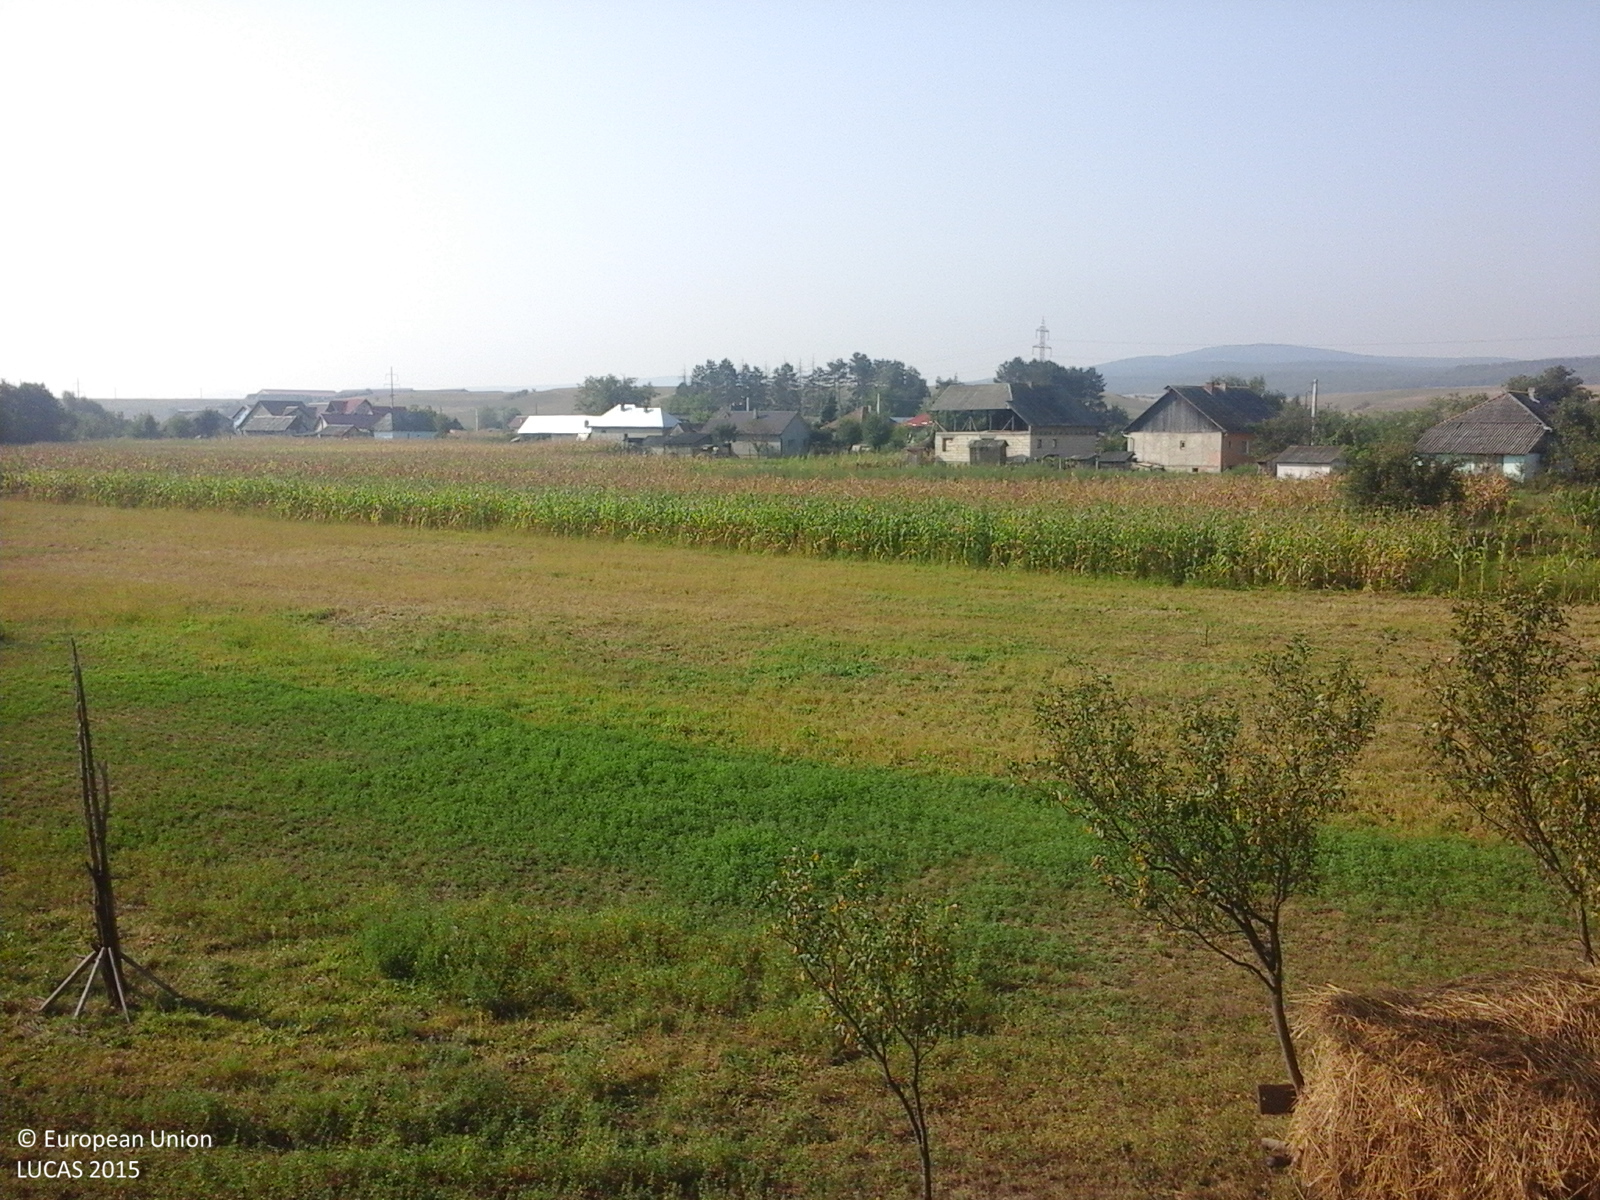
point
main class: Grassland
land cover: Grassland without tree/shrub cover
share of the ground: > 75 %
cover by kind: herbaceous plants 100 %
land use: Agriculture (excluding fallow land and kitchen gardens)
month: September
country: RO
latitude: 47.1793
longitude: 24.2716
